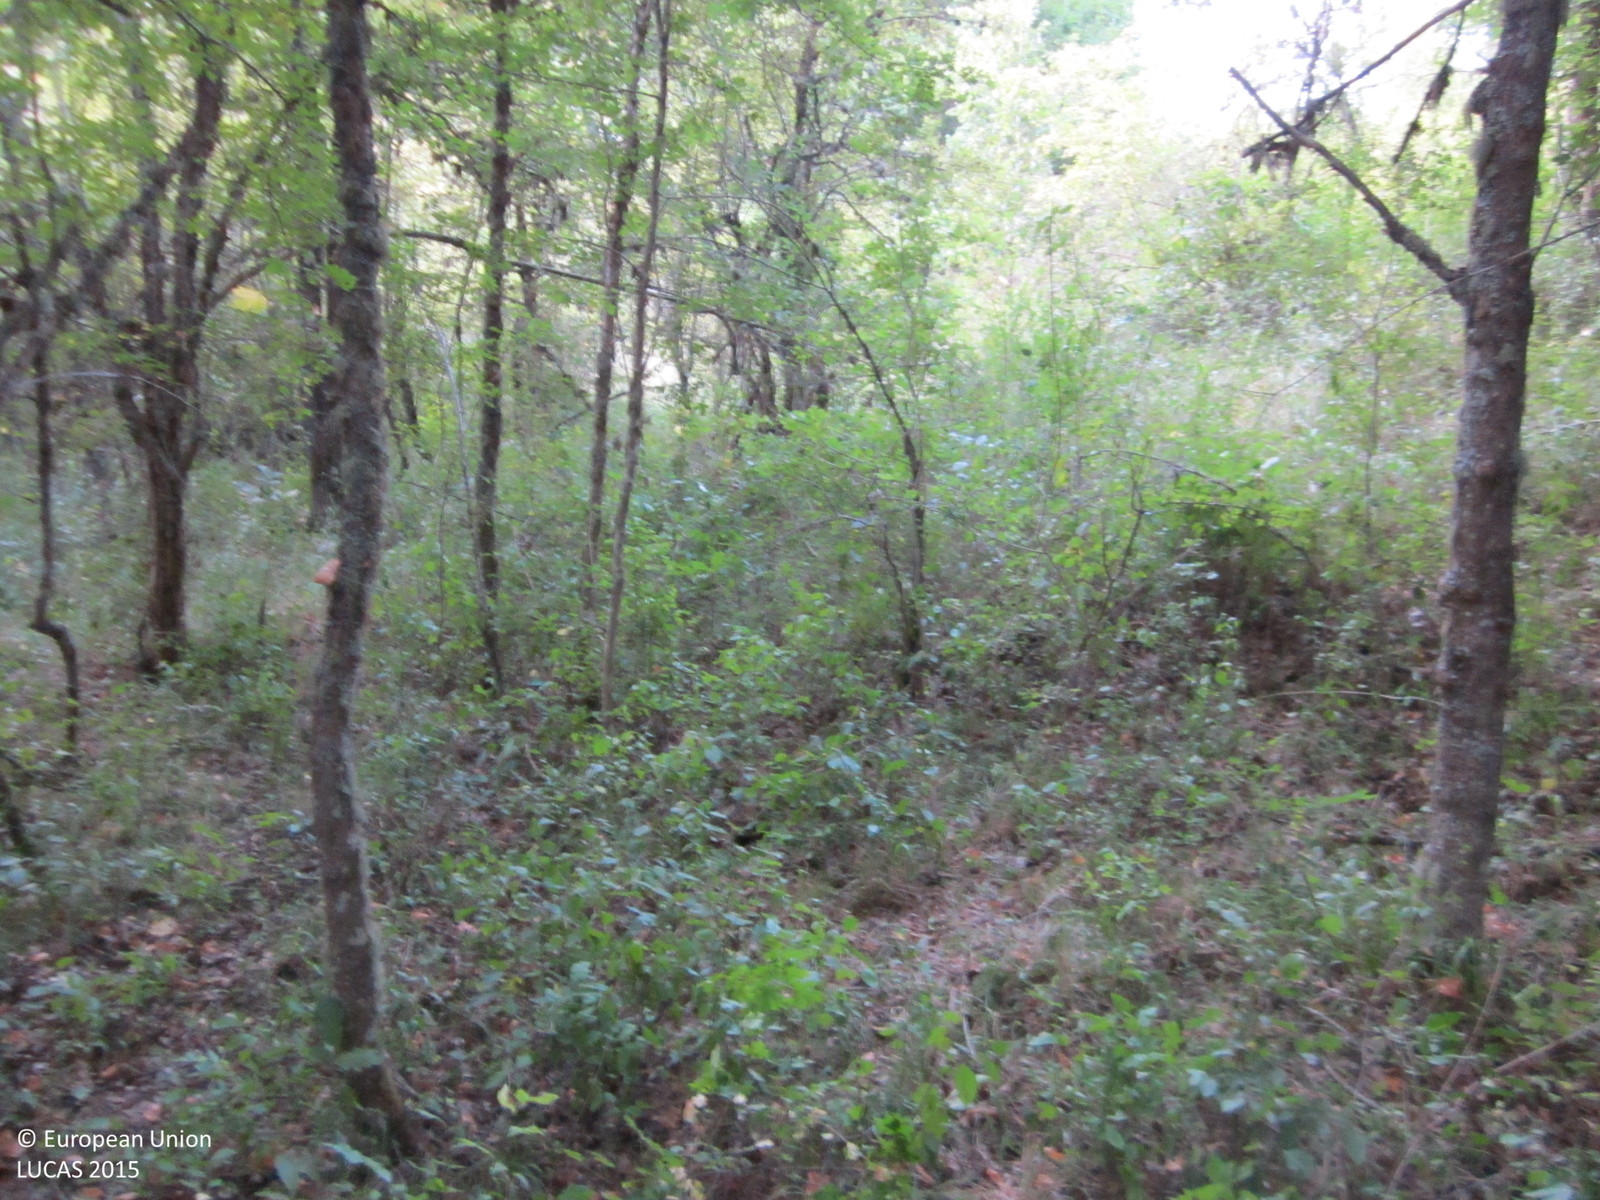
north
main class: Woodland
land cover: Broadleaved woodland
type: thermophilous deciduous forest
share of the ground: > 75 %
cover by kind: broadleaved forest trees 90 %, unconsolidated bare surface 10 %
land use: Forestry
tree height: > 5 m
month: August
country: BG
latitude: 41.9741
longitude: 27.5498
